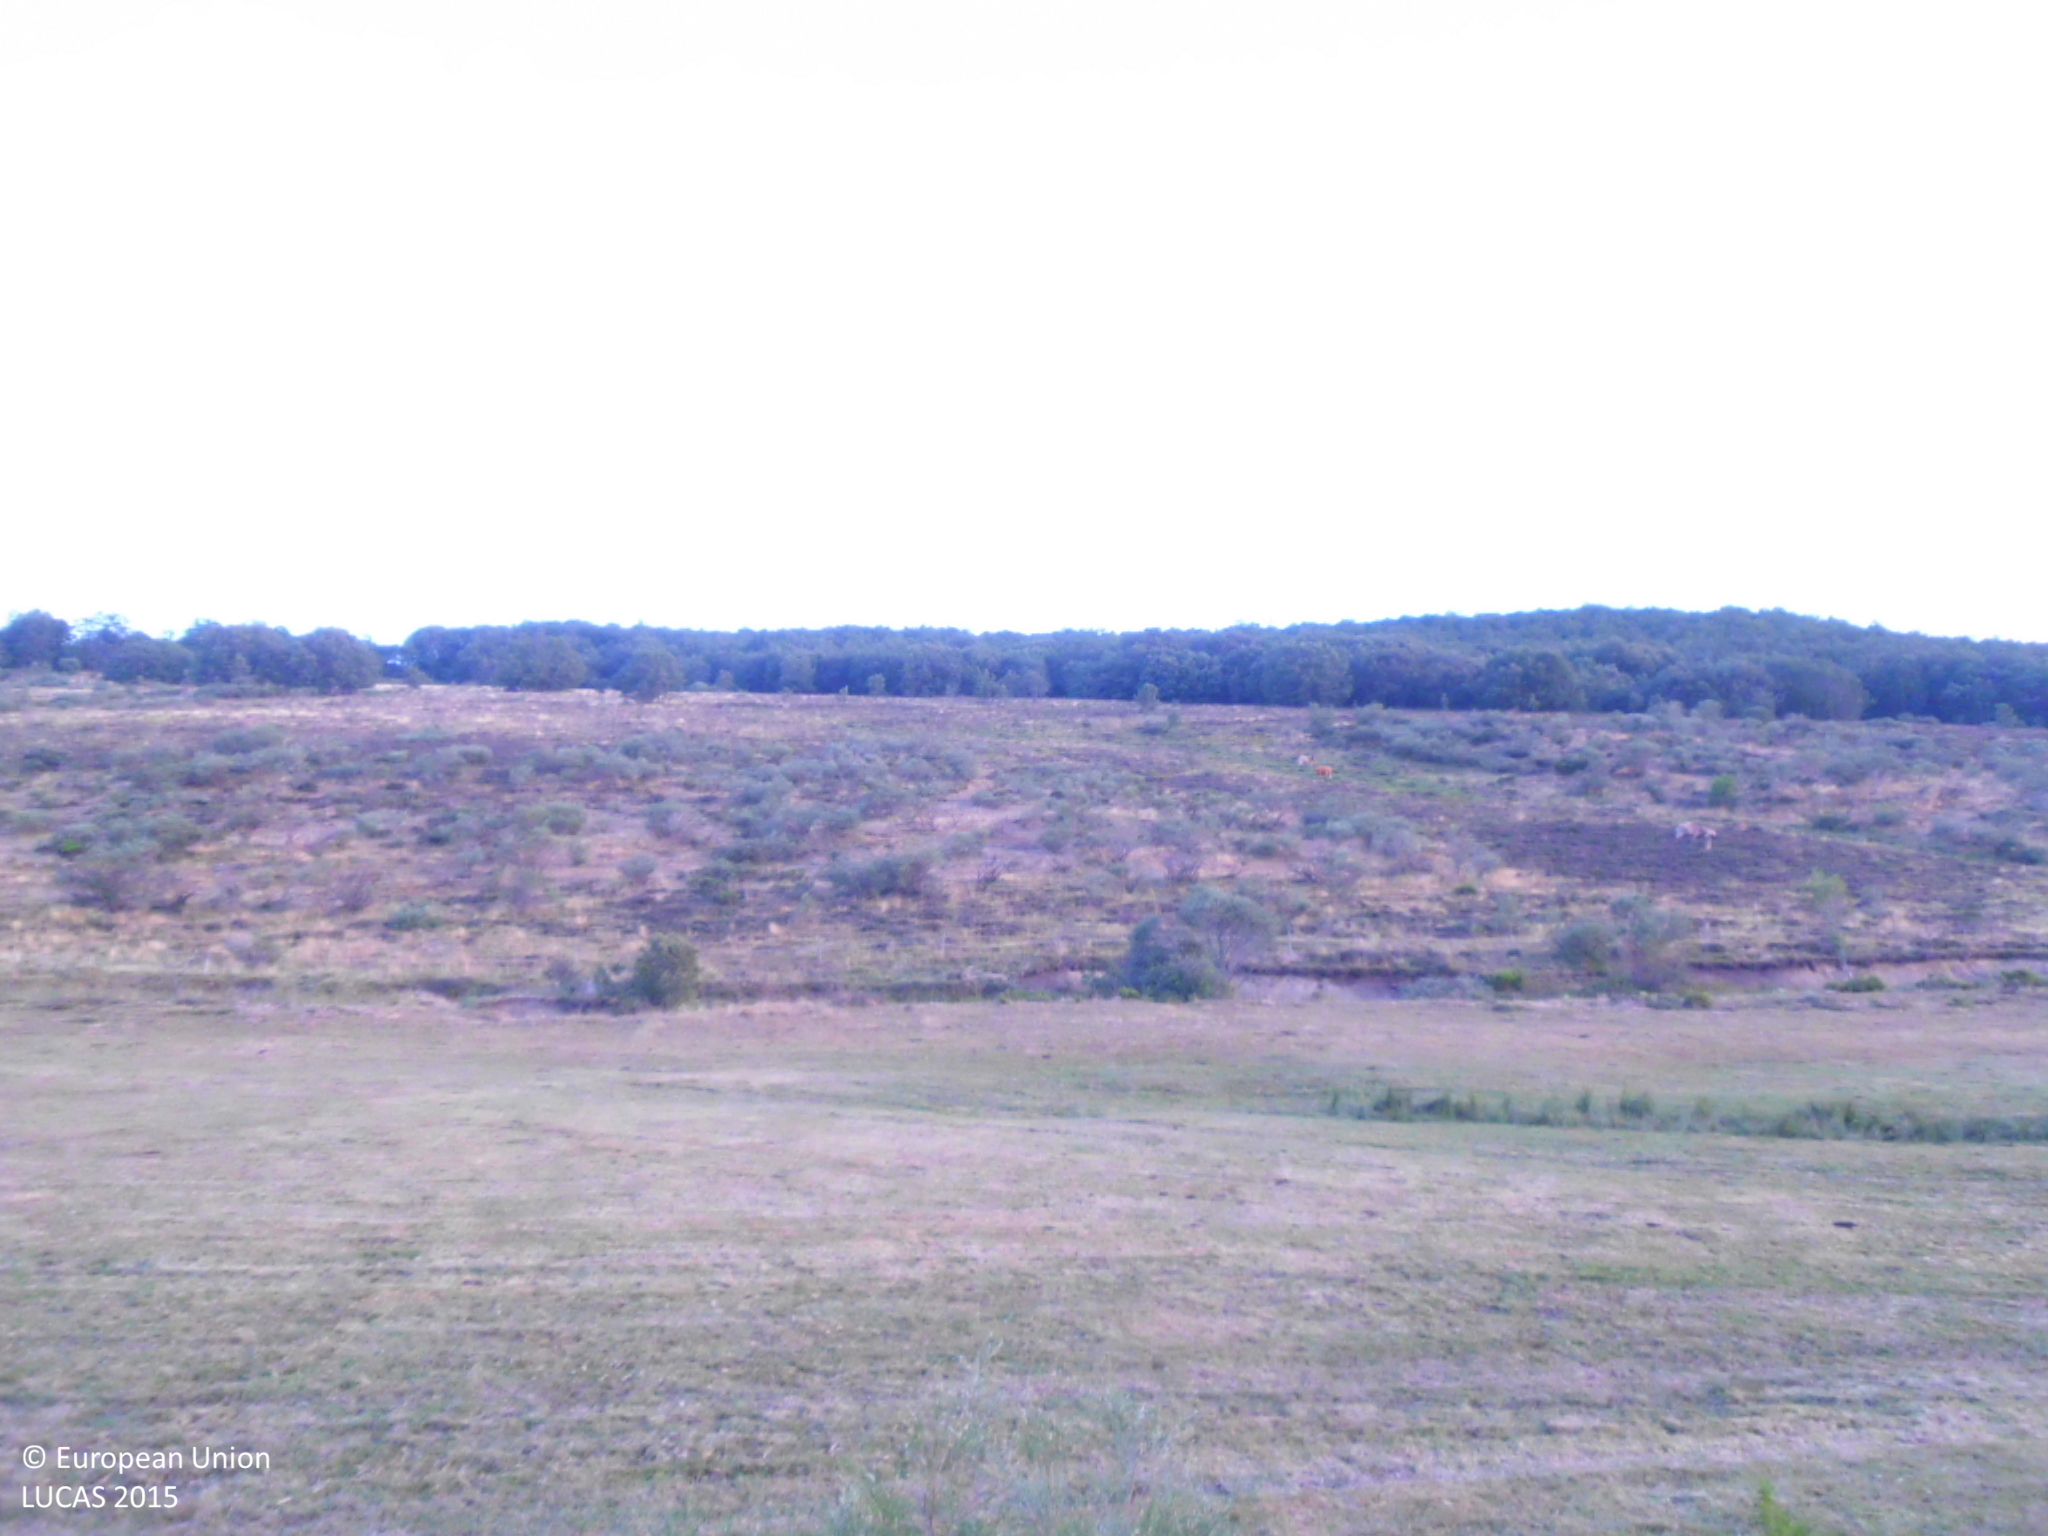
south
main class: Grassland
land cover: Grassland without tree/shrub cover
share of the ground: > 75 %
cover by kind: herbaceous plants 100 %
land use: Agriculture (excluding fallow land and kitchen gardens)
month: July
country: ES
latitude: 42.9334
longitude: -4.4278
